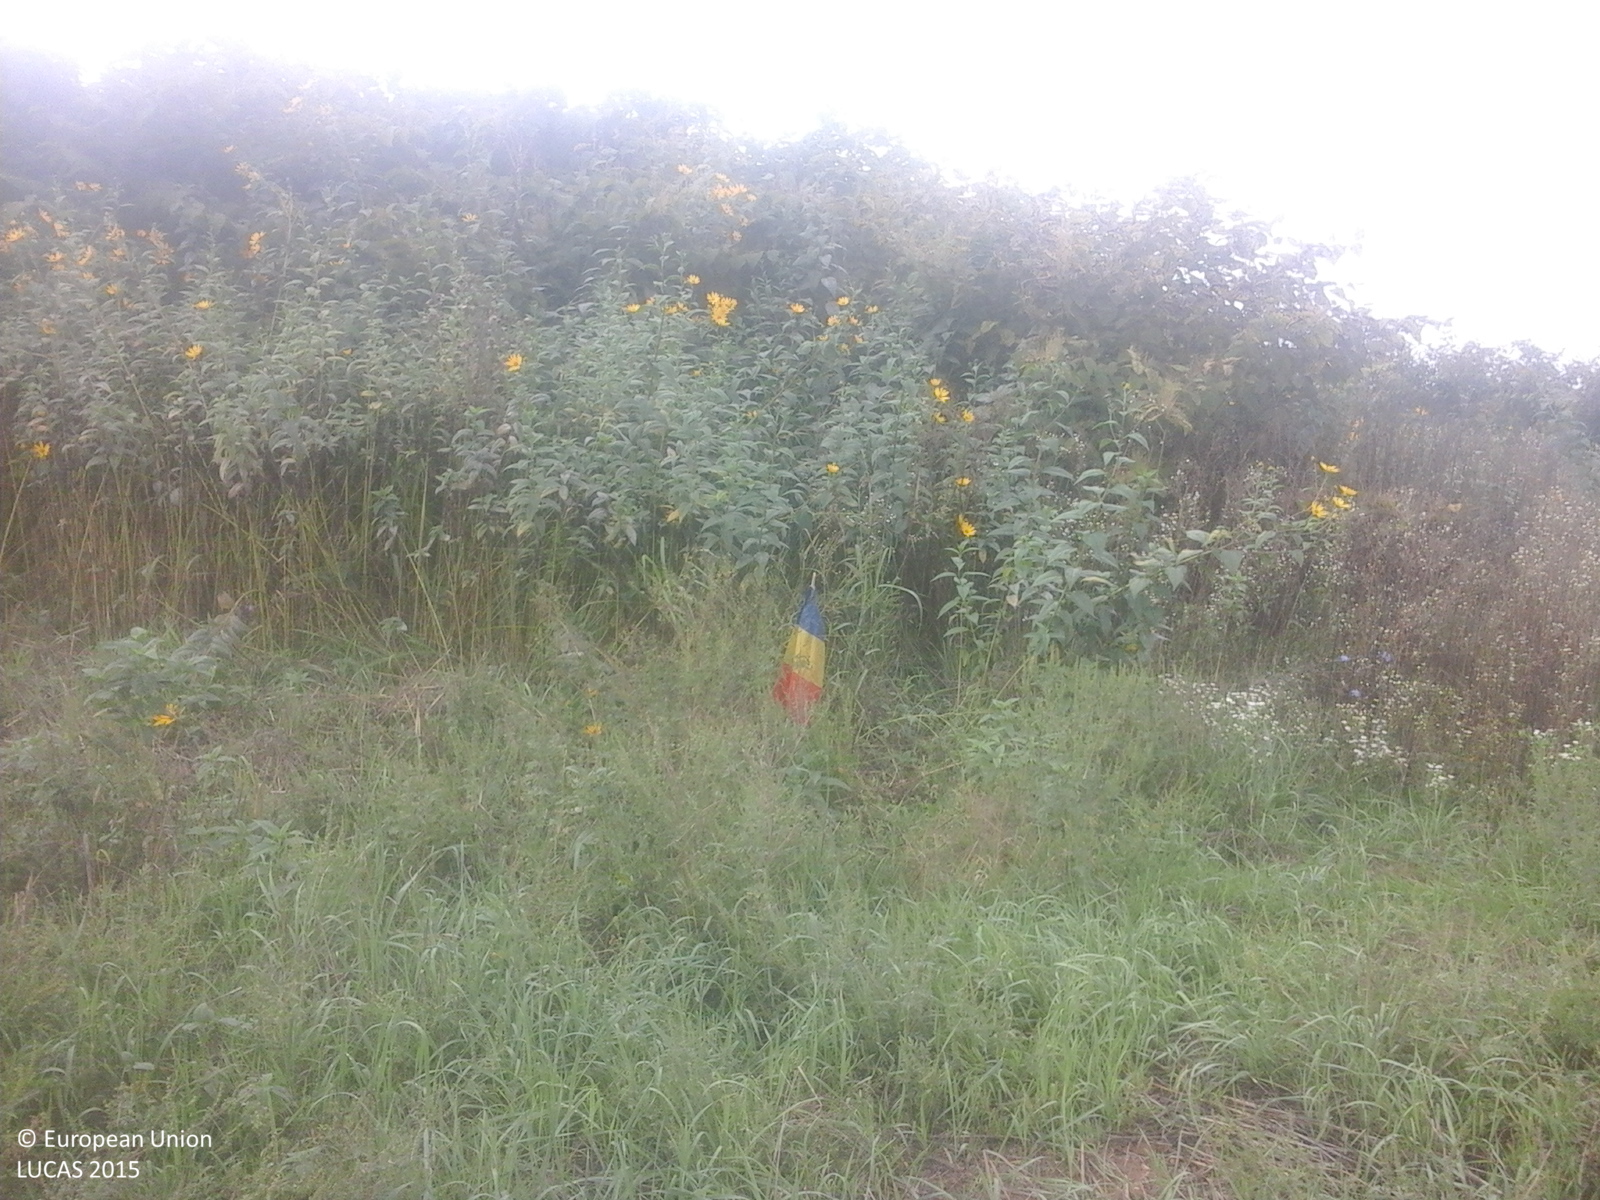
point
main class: Grassland
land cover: Spontaneously vegetated surfaces
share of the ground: > 75 %
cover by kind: herbaceous plants 100 %
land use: Fallow land
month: September
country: RO
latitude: 45.8546
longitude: 22.1617
